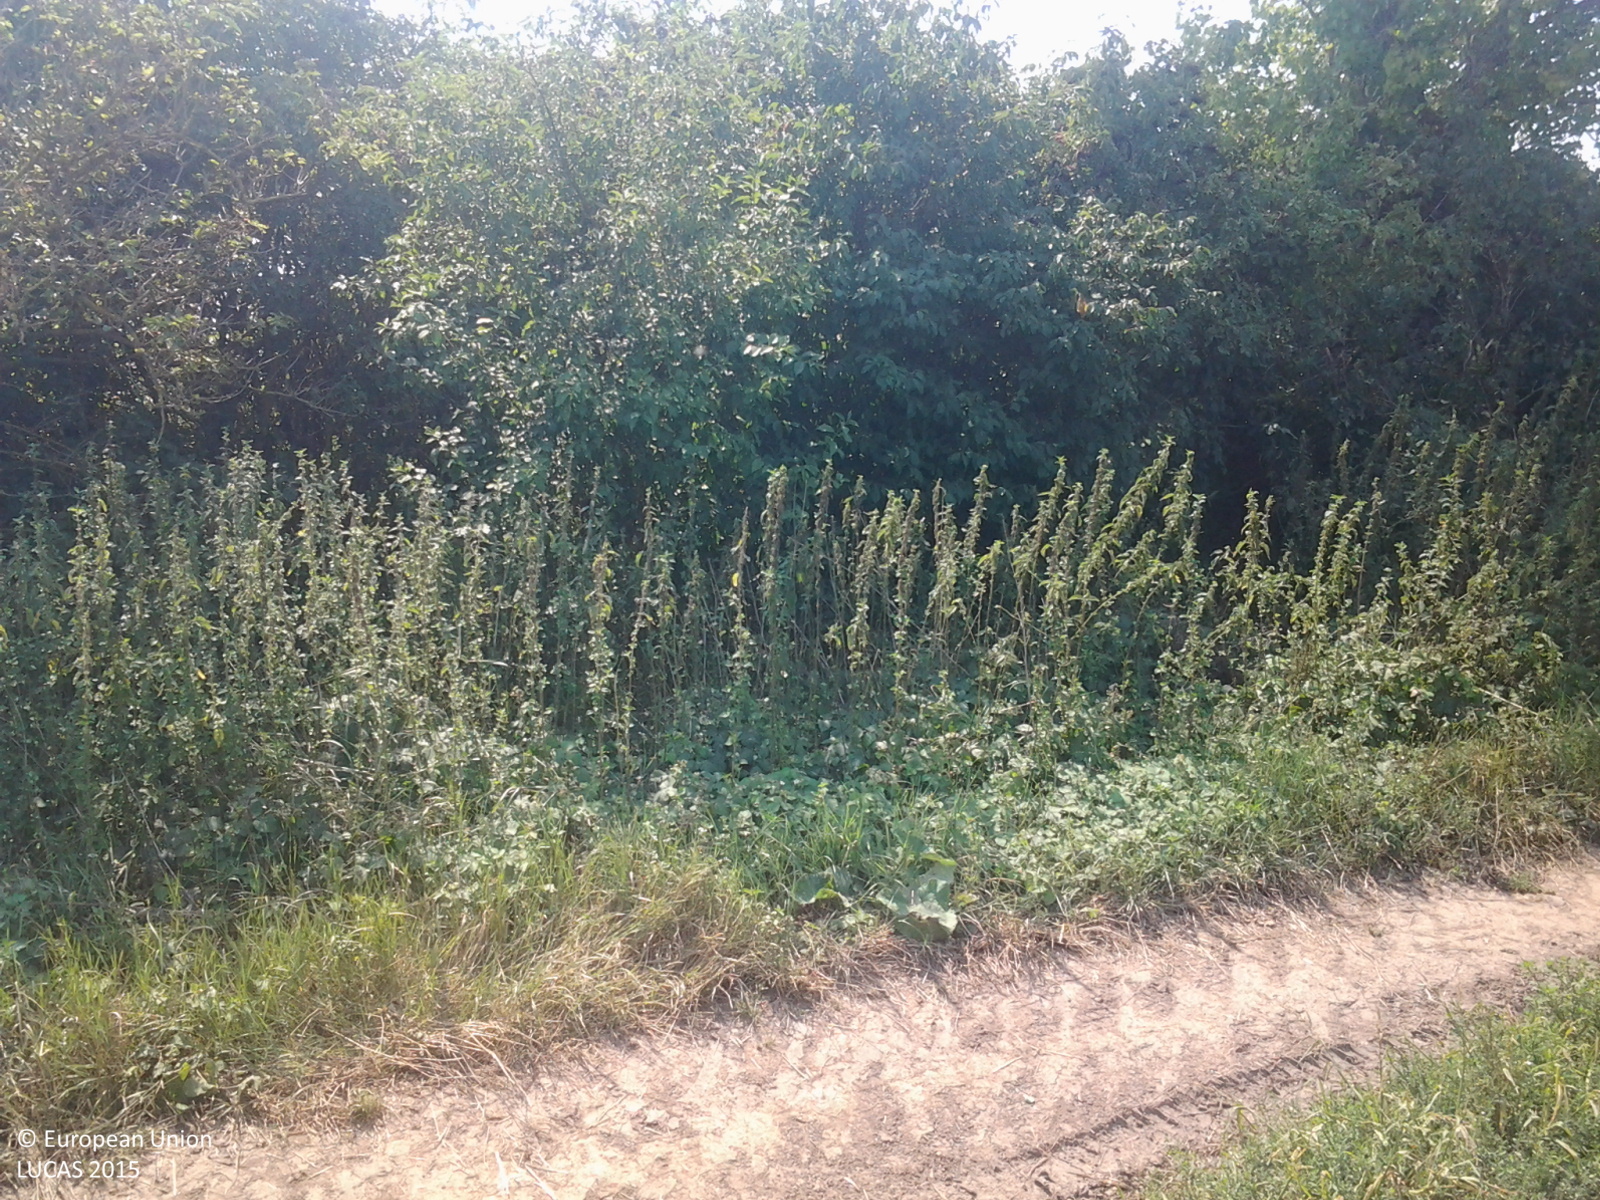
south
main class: Cropland
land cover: Sunflower
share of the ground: > 75 %
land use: Agriculture (excluding fallow land and kitchen gardens)
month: August
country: HU
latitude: 46.6371
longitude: 18.3835
